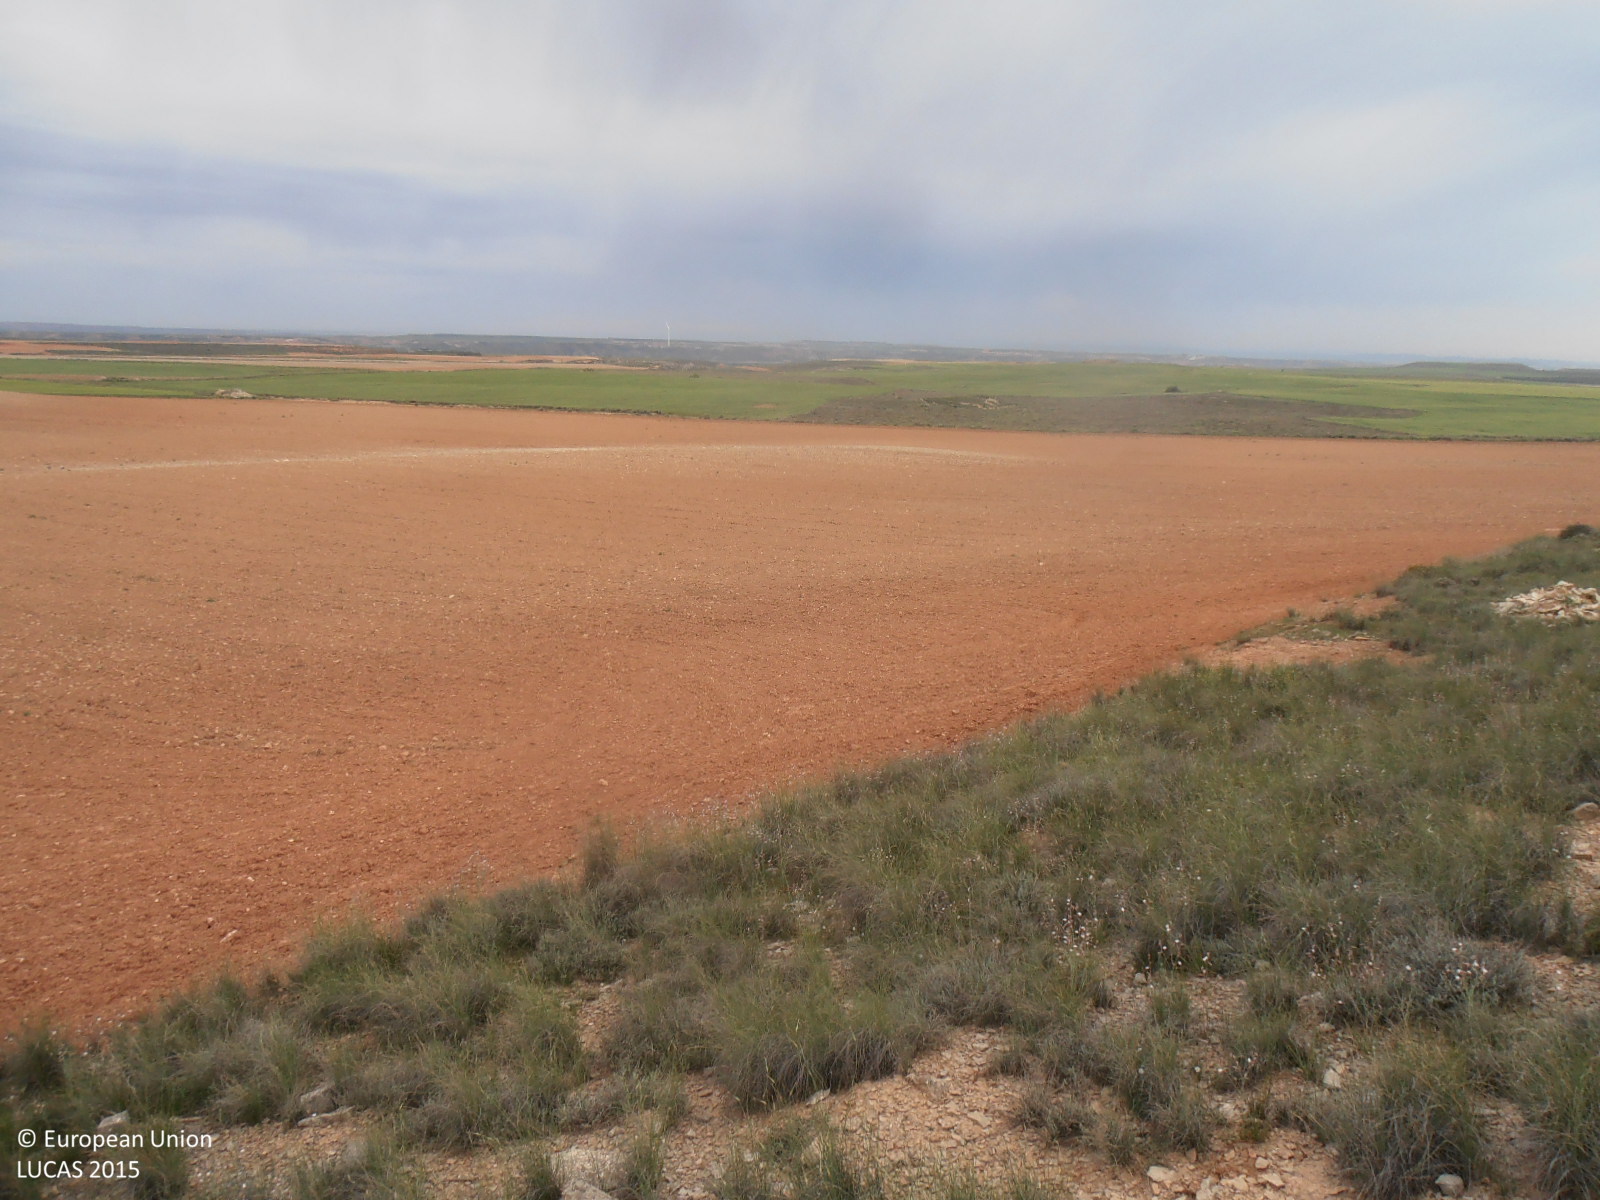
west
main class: Shrubland
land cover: Shrubland without tree cover
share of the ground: 50 - 75 %
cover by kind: shrubs 50 %, herbaceous plants 25 %, consolidated bare surface 25 %
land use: Semi-natural and natural areas not in use
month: April
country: ES
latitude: 41.3883
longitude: -0.4084
